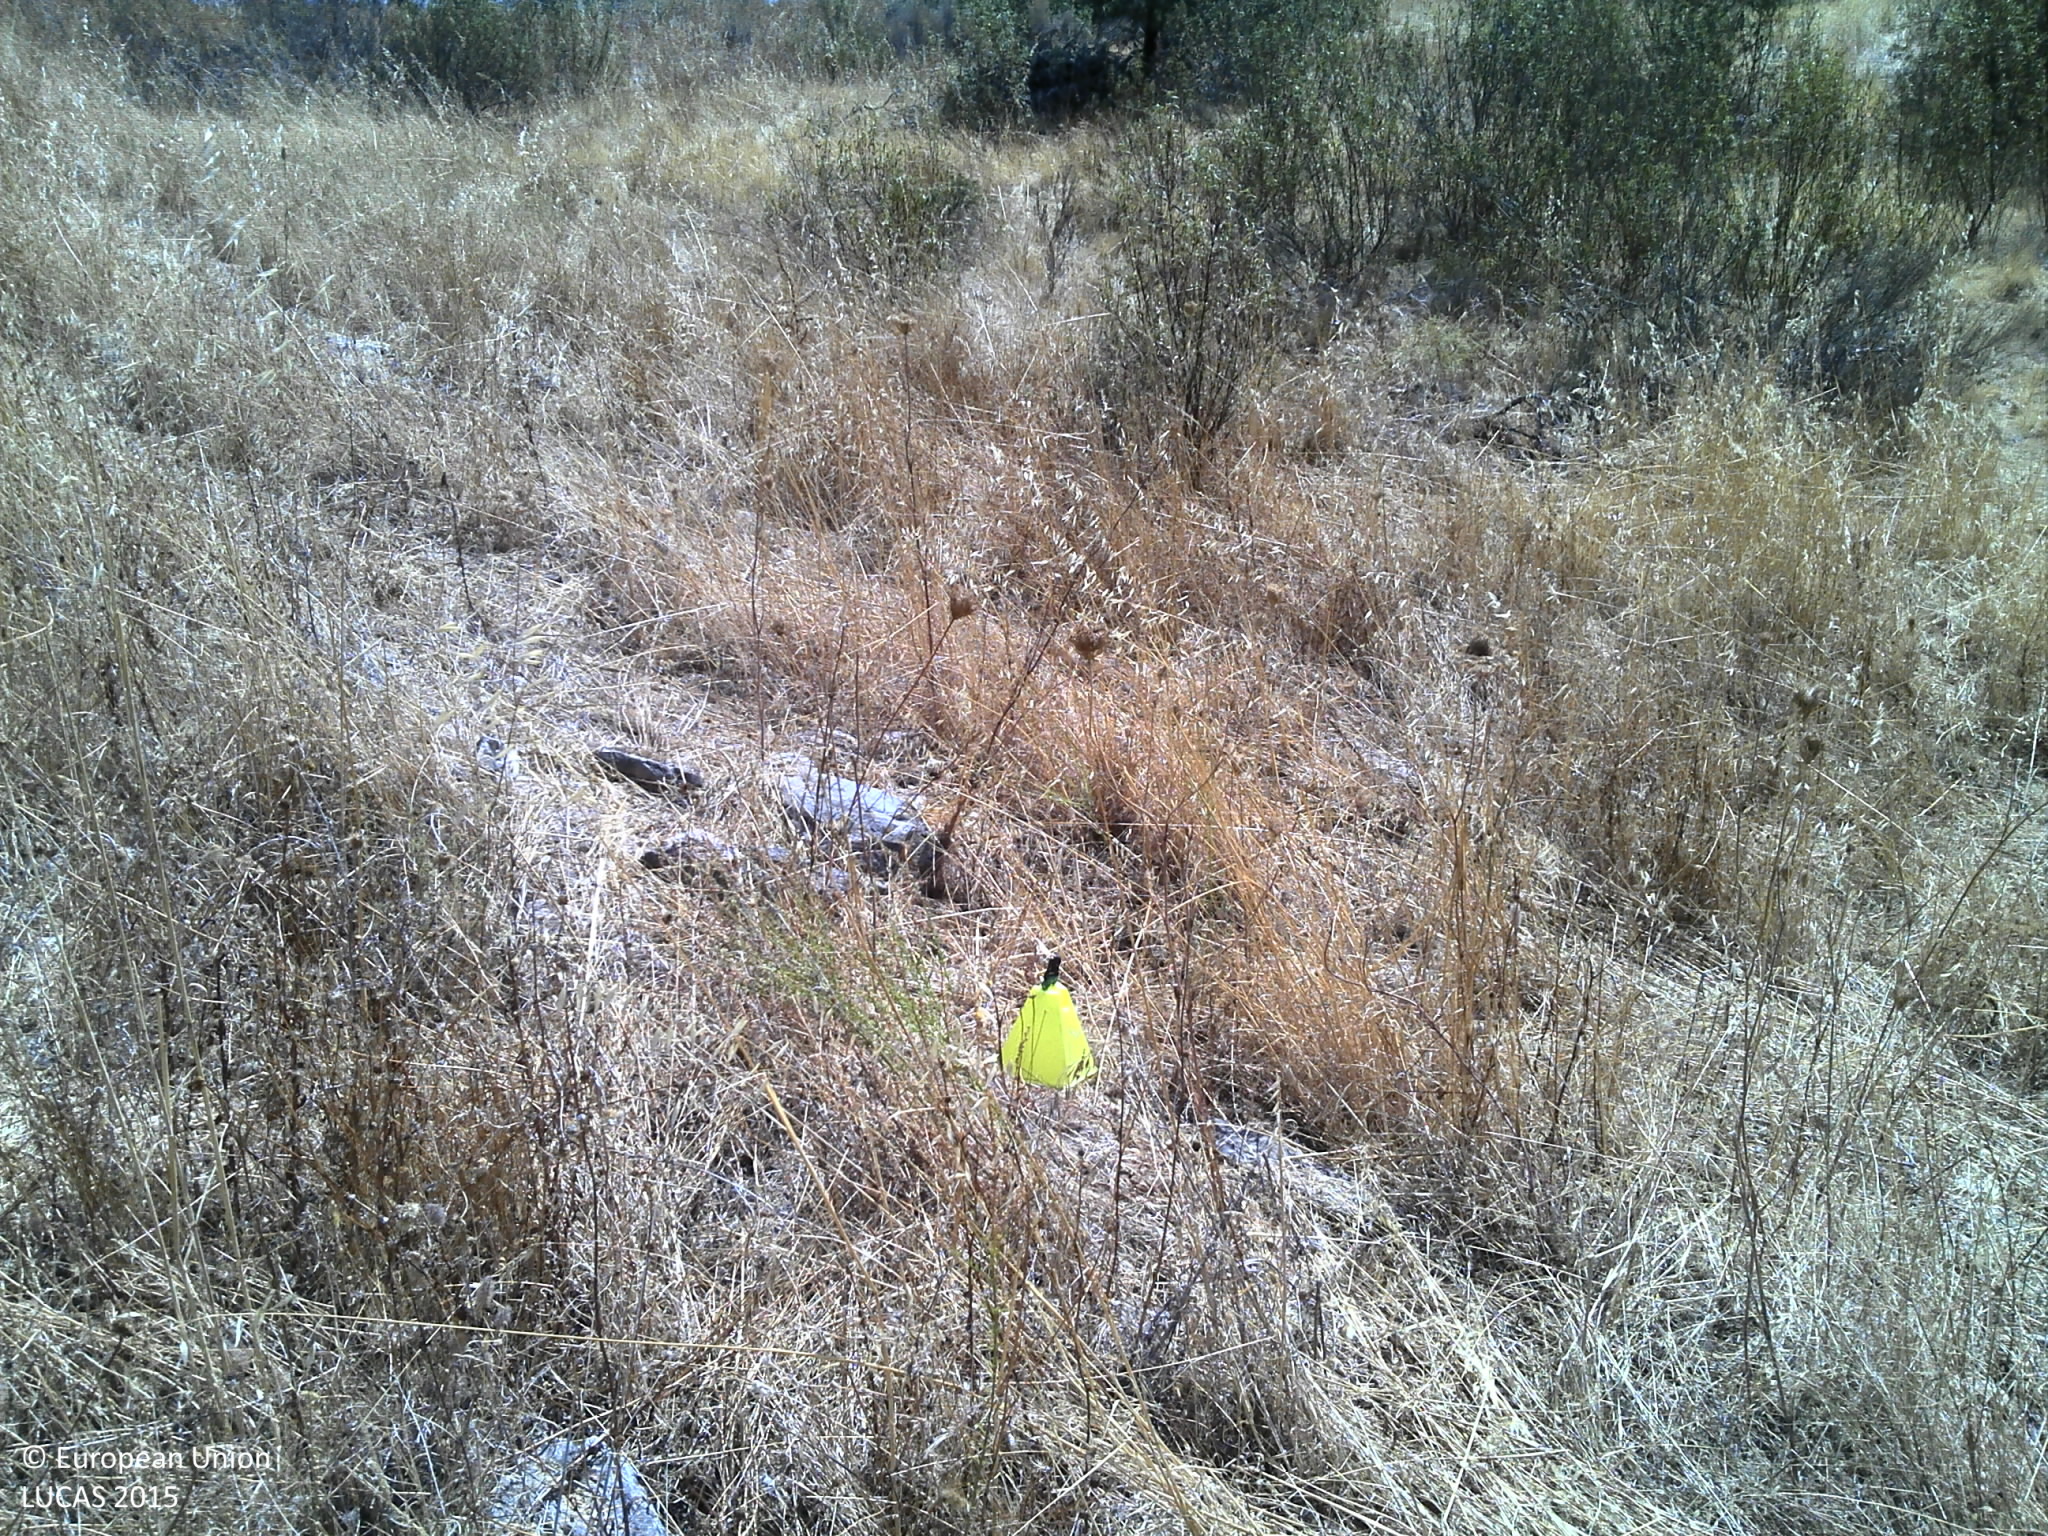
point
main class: Grassland
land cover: Grassland without tree/shrub cover
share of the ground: 25 - 50 %
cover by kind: unconsolidated bare surface 65 %, herbaceous plants 30 %, shrubs 5 %
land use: Agriculture (excluding fallow land and kitchen gardens)
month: July
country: PT
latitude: 38.5171
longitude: -7.6841
